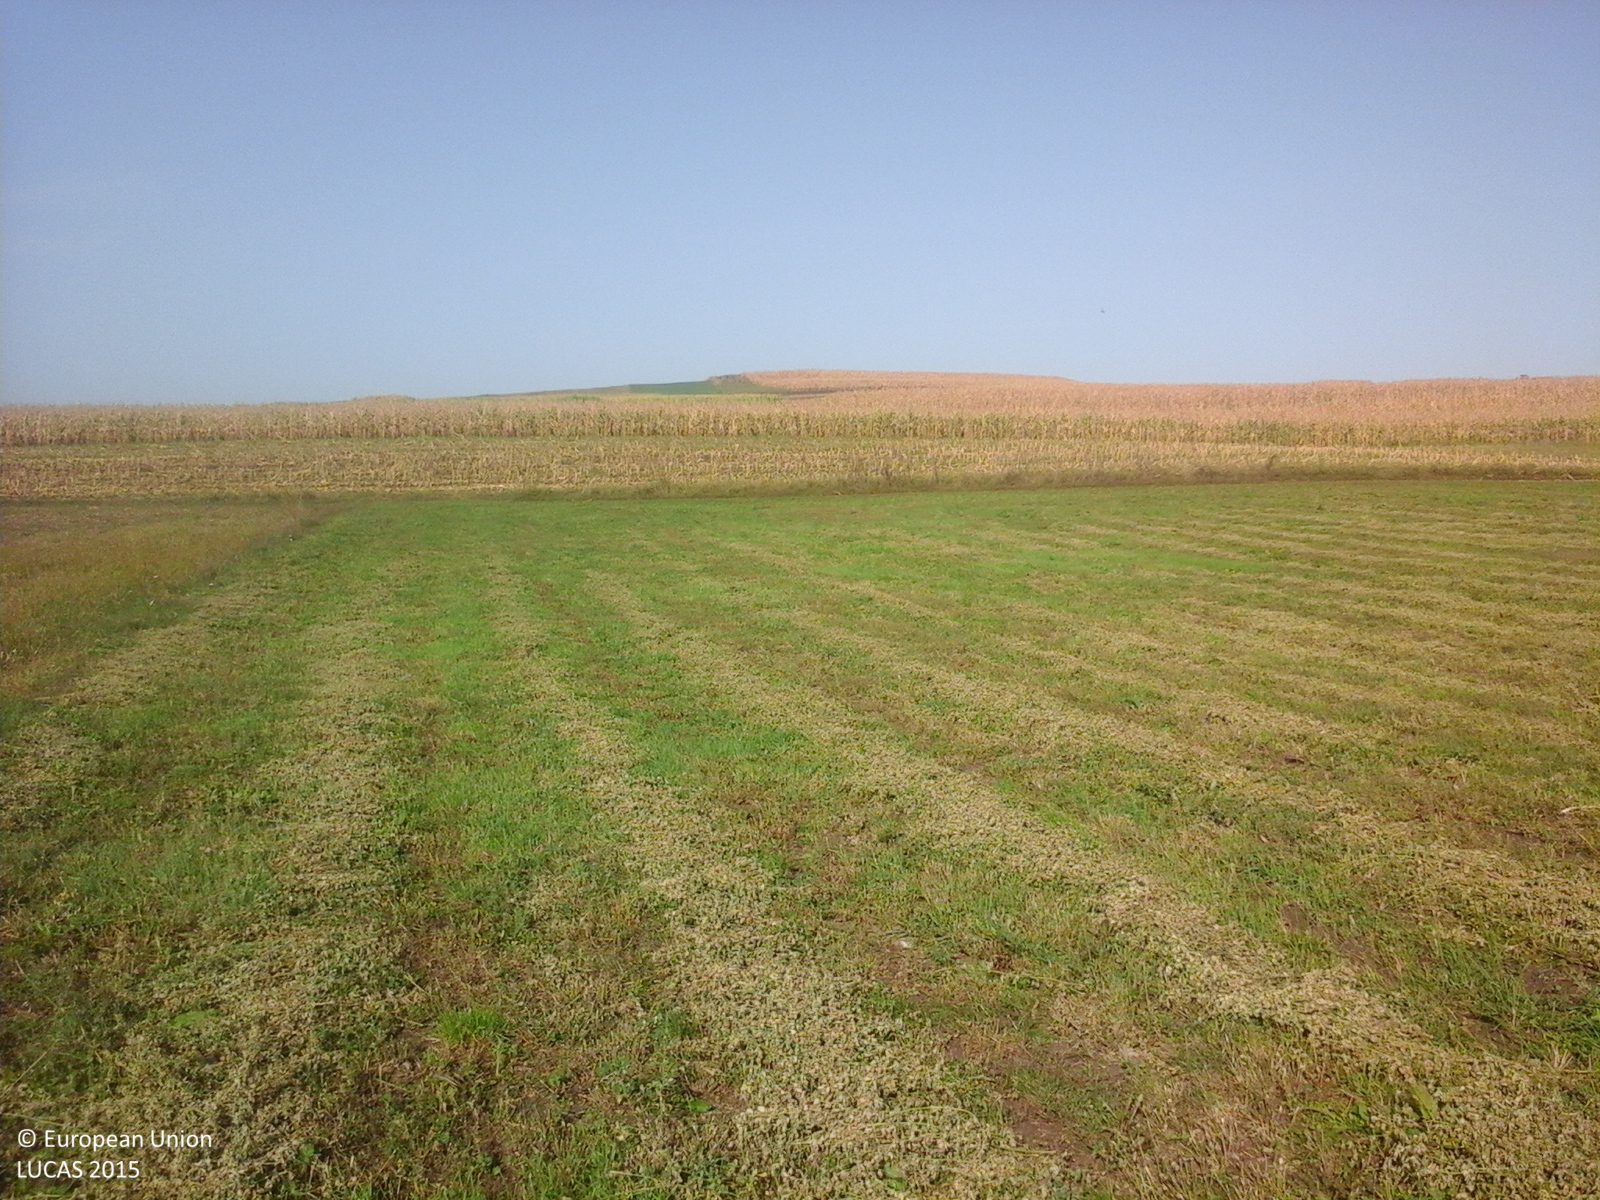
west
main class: Cropland
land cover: Lucerne
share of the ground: > 75 %
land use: Agriculture (excluding fallow land and kitchen gardens)
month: September
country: RO
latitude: 46.7027
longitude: 24.0074
